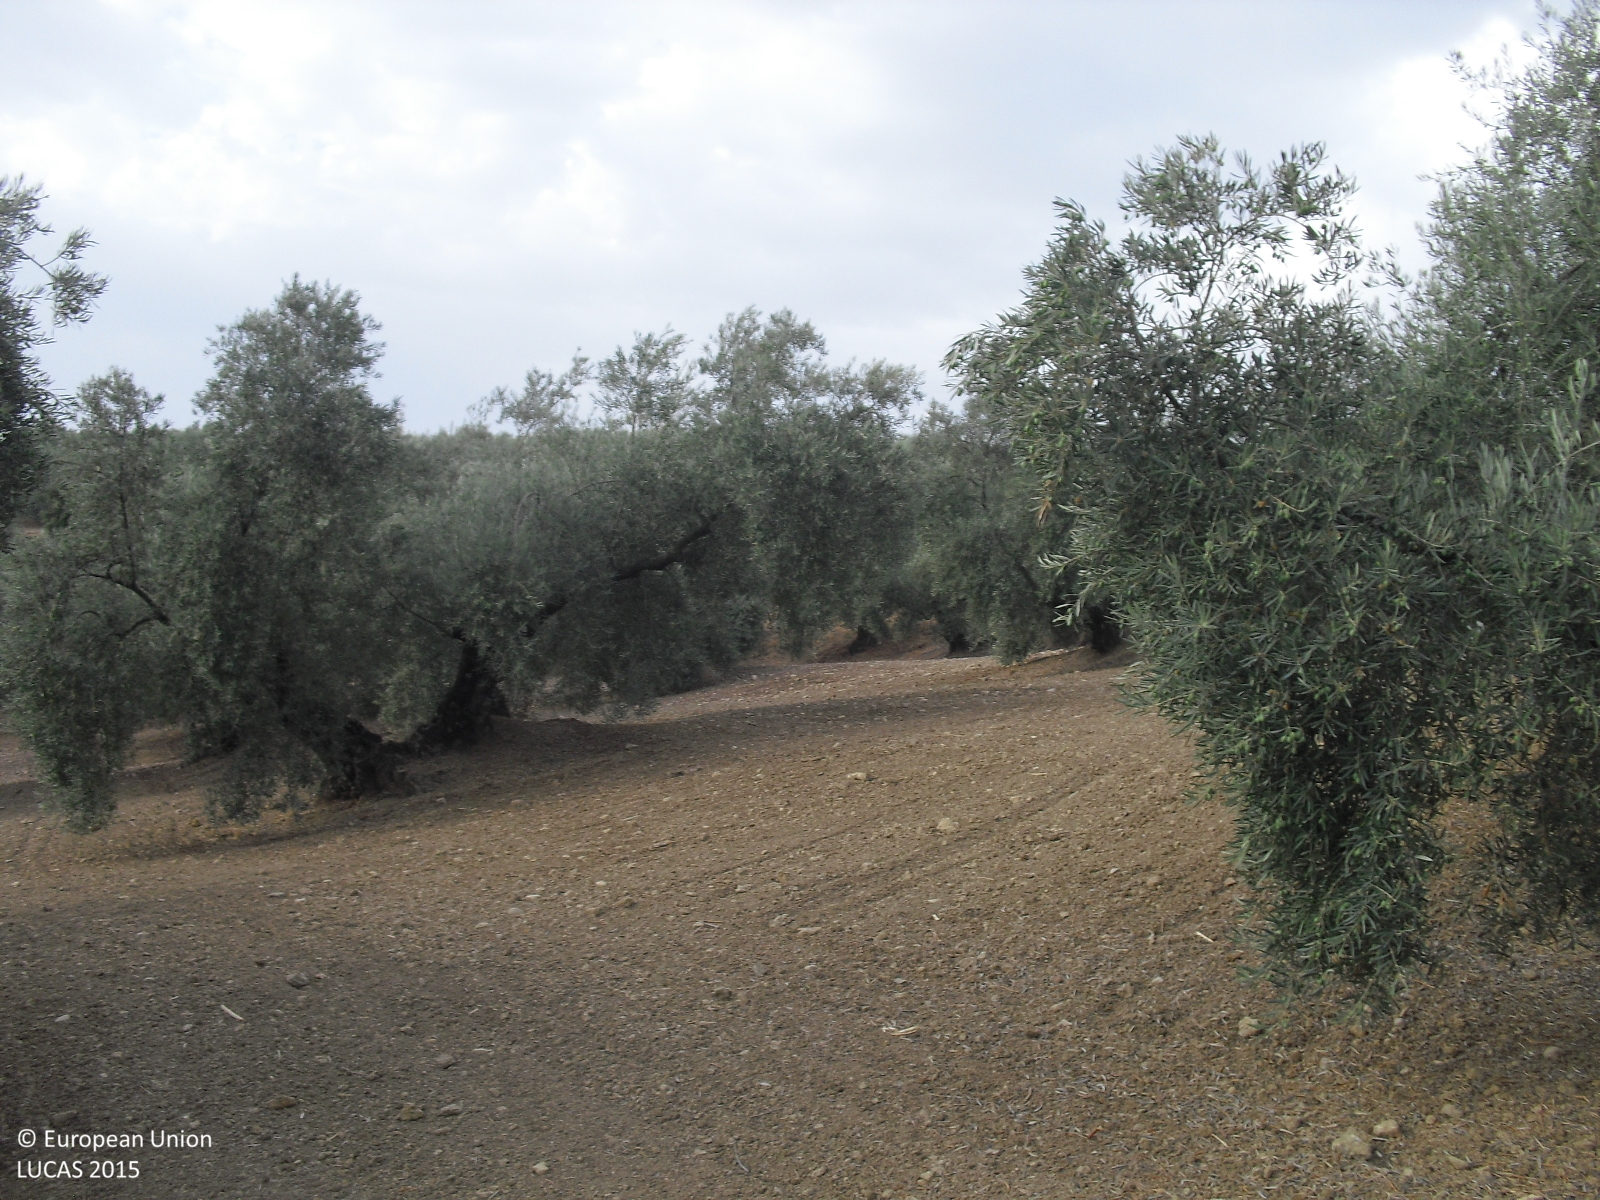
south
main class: Cropland
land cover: Olive groves
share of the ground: 25 - 50 %
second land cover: Other bare soil
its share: > 75 %
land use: Agriculture (excluding fallow land and kitchen gardens)
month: August
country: ES
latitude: 37.3273
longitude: -4.3892
